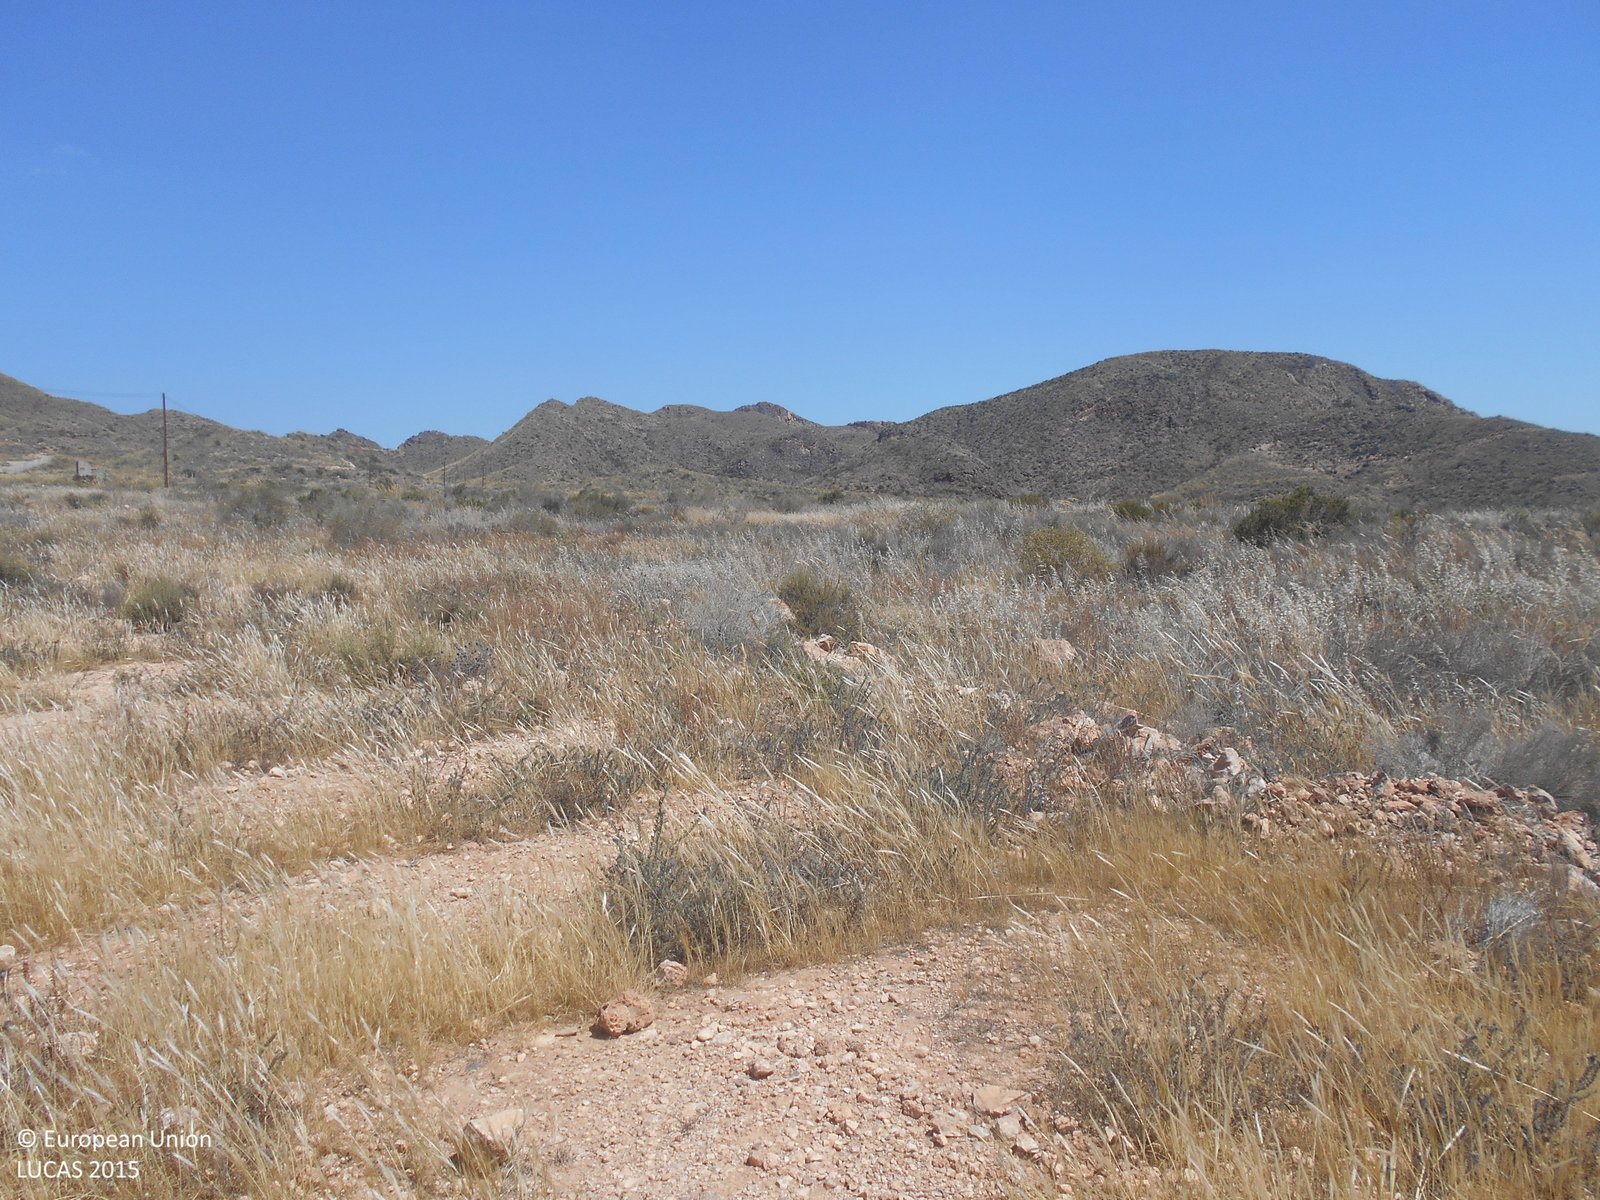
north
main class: Shrubland
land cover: Shrubland without tree cover
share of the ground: 50 - 75 %
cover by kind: herbaceous plants 40 %, shrubs 20 %, consolidated bare surface 20 %, unconsolidated bare surface 20 %
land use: Semi-natural and natural areas not in use
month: May
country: ES
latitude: 37.5481
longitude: -1.4456
